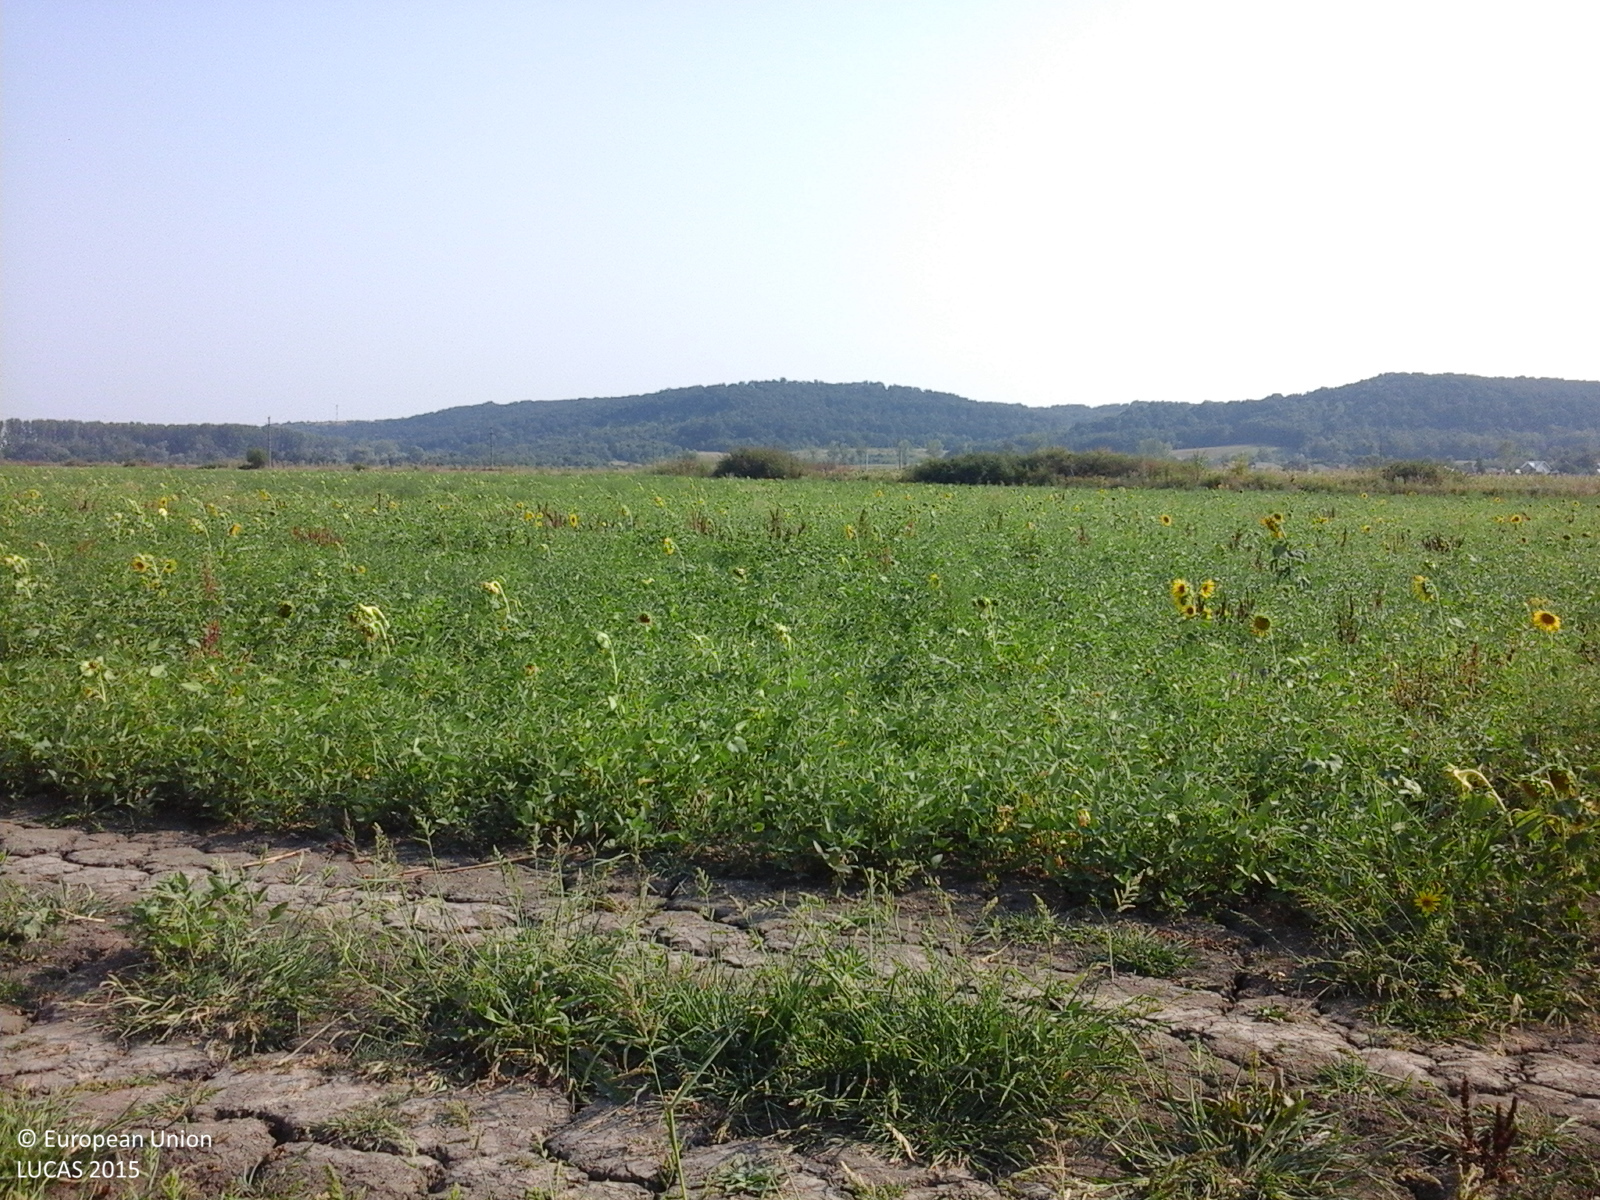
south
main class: Grassland
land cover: Spontaneously vegetated surfaces
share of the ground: > 75 %
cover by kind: herbaceous plants 100 %
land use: Agriculture (excluding fallow land and kitchen gardens)
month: August
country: RO
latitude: 44.3903
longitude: 23.6758
